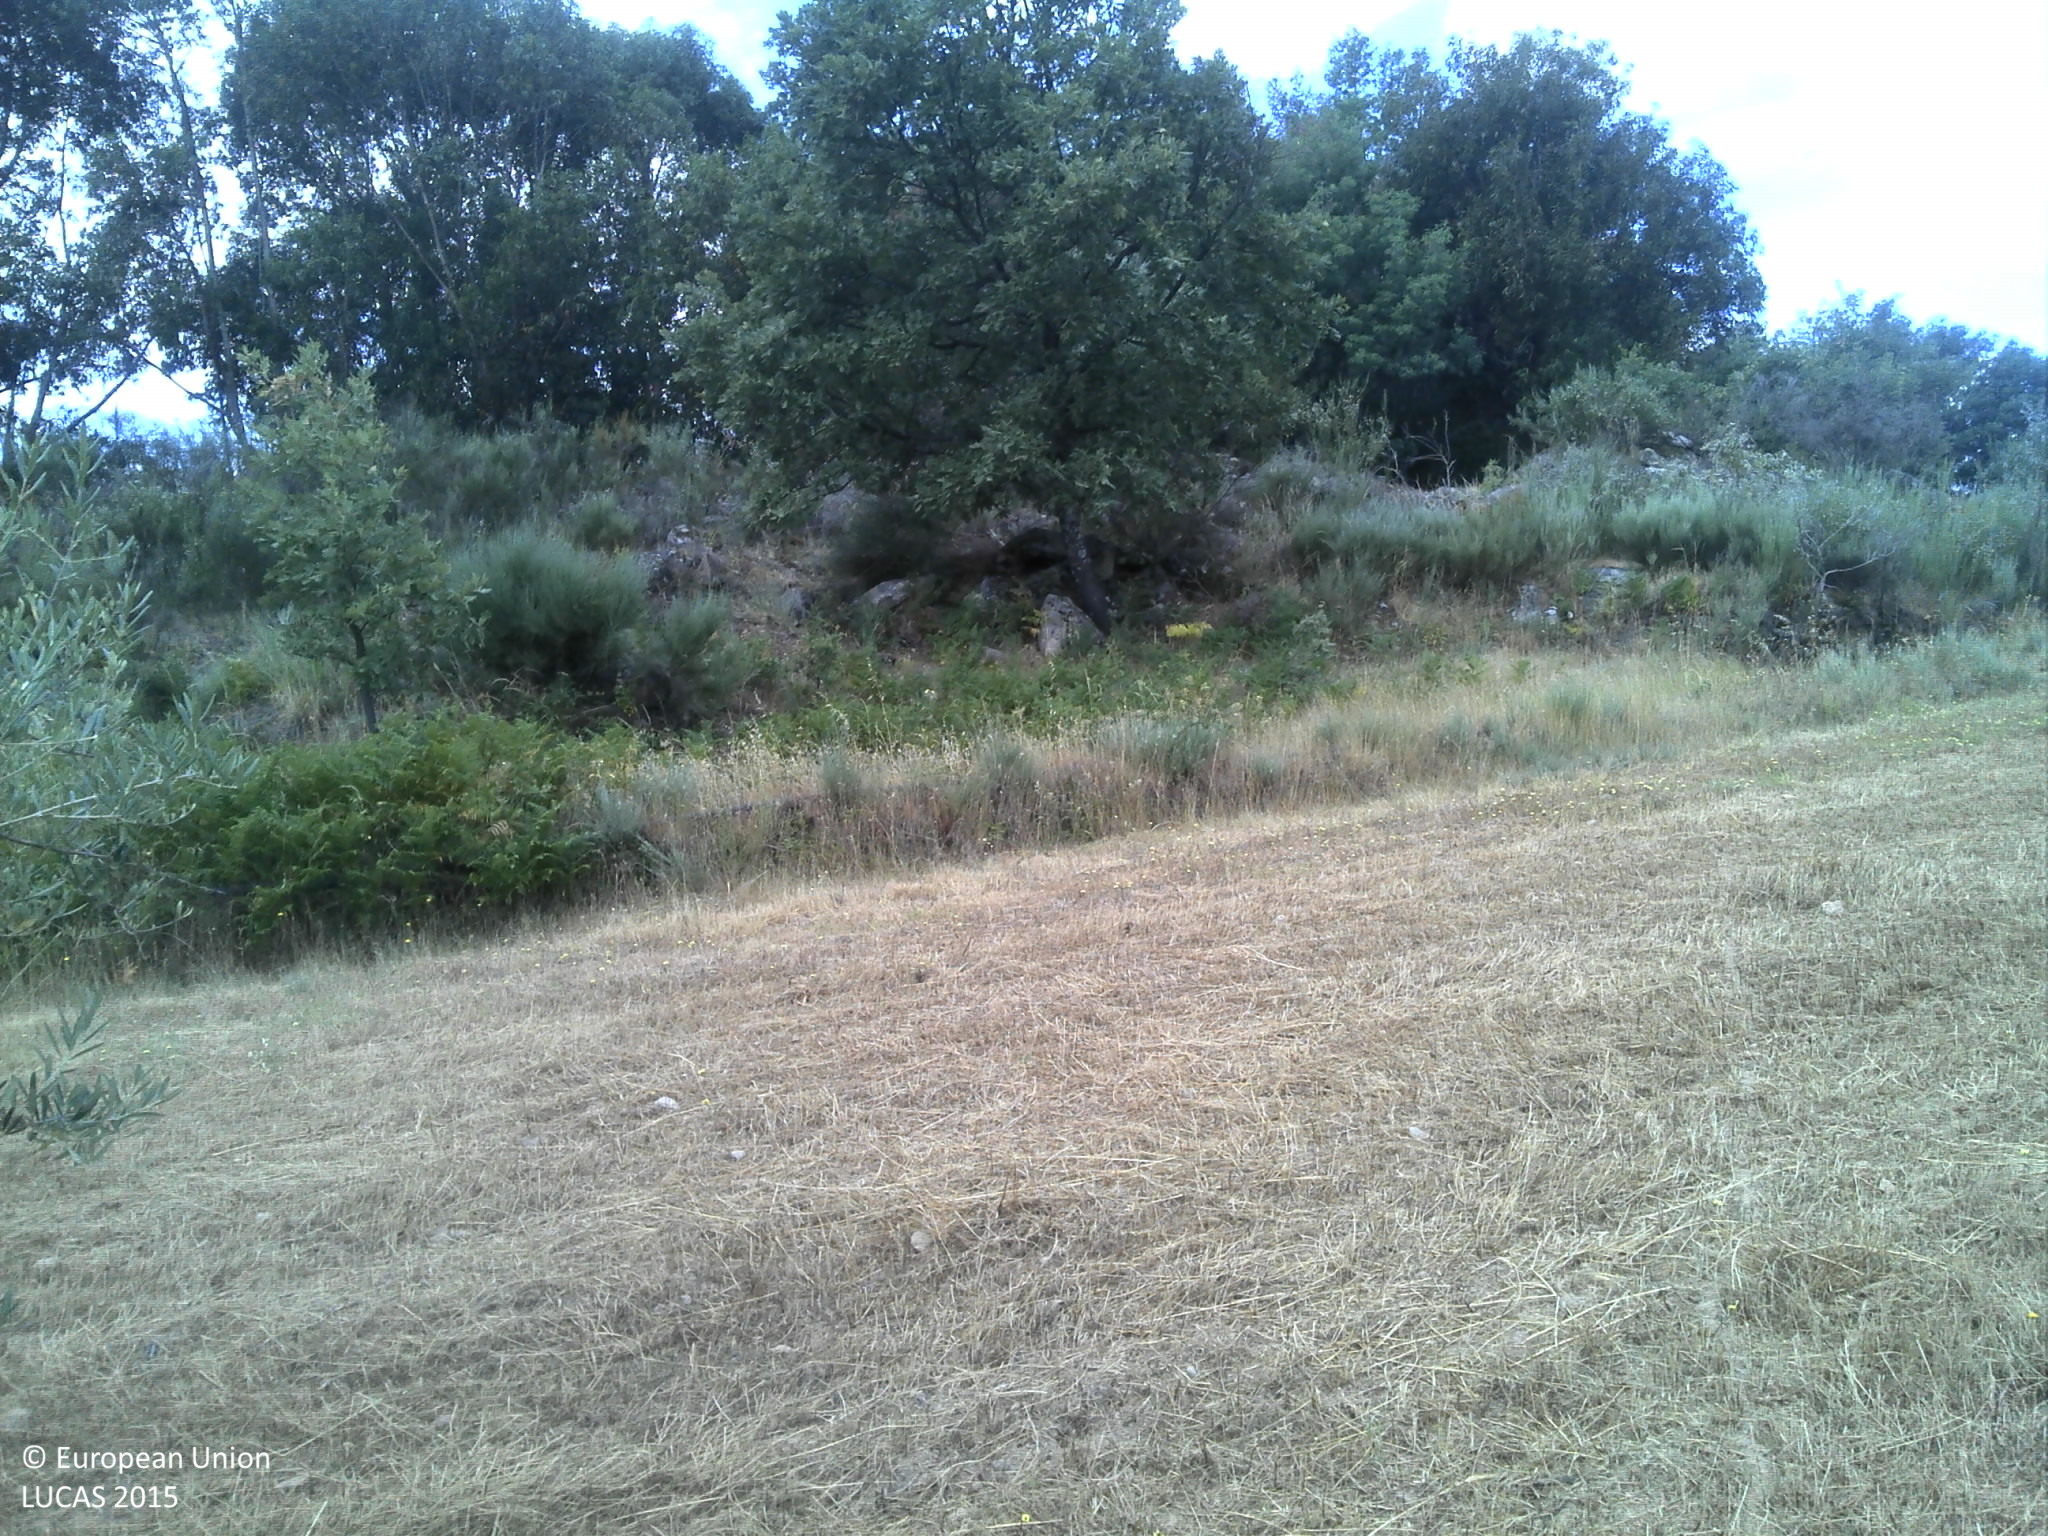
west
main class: Cropland
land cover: Olive groves
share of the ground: 10 - 25 %
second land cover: Spontaneously vegetated surfaces
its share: < 10 %
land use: Agriculture (excluding fallow land and kitchen gardens)
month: June
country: PT
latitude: 40.1348
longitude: -7.3175
